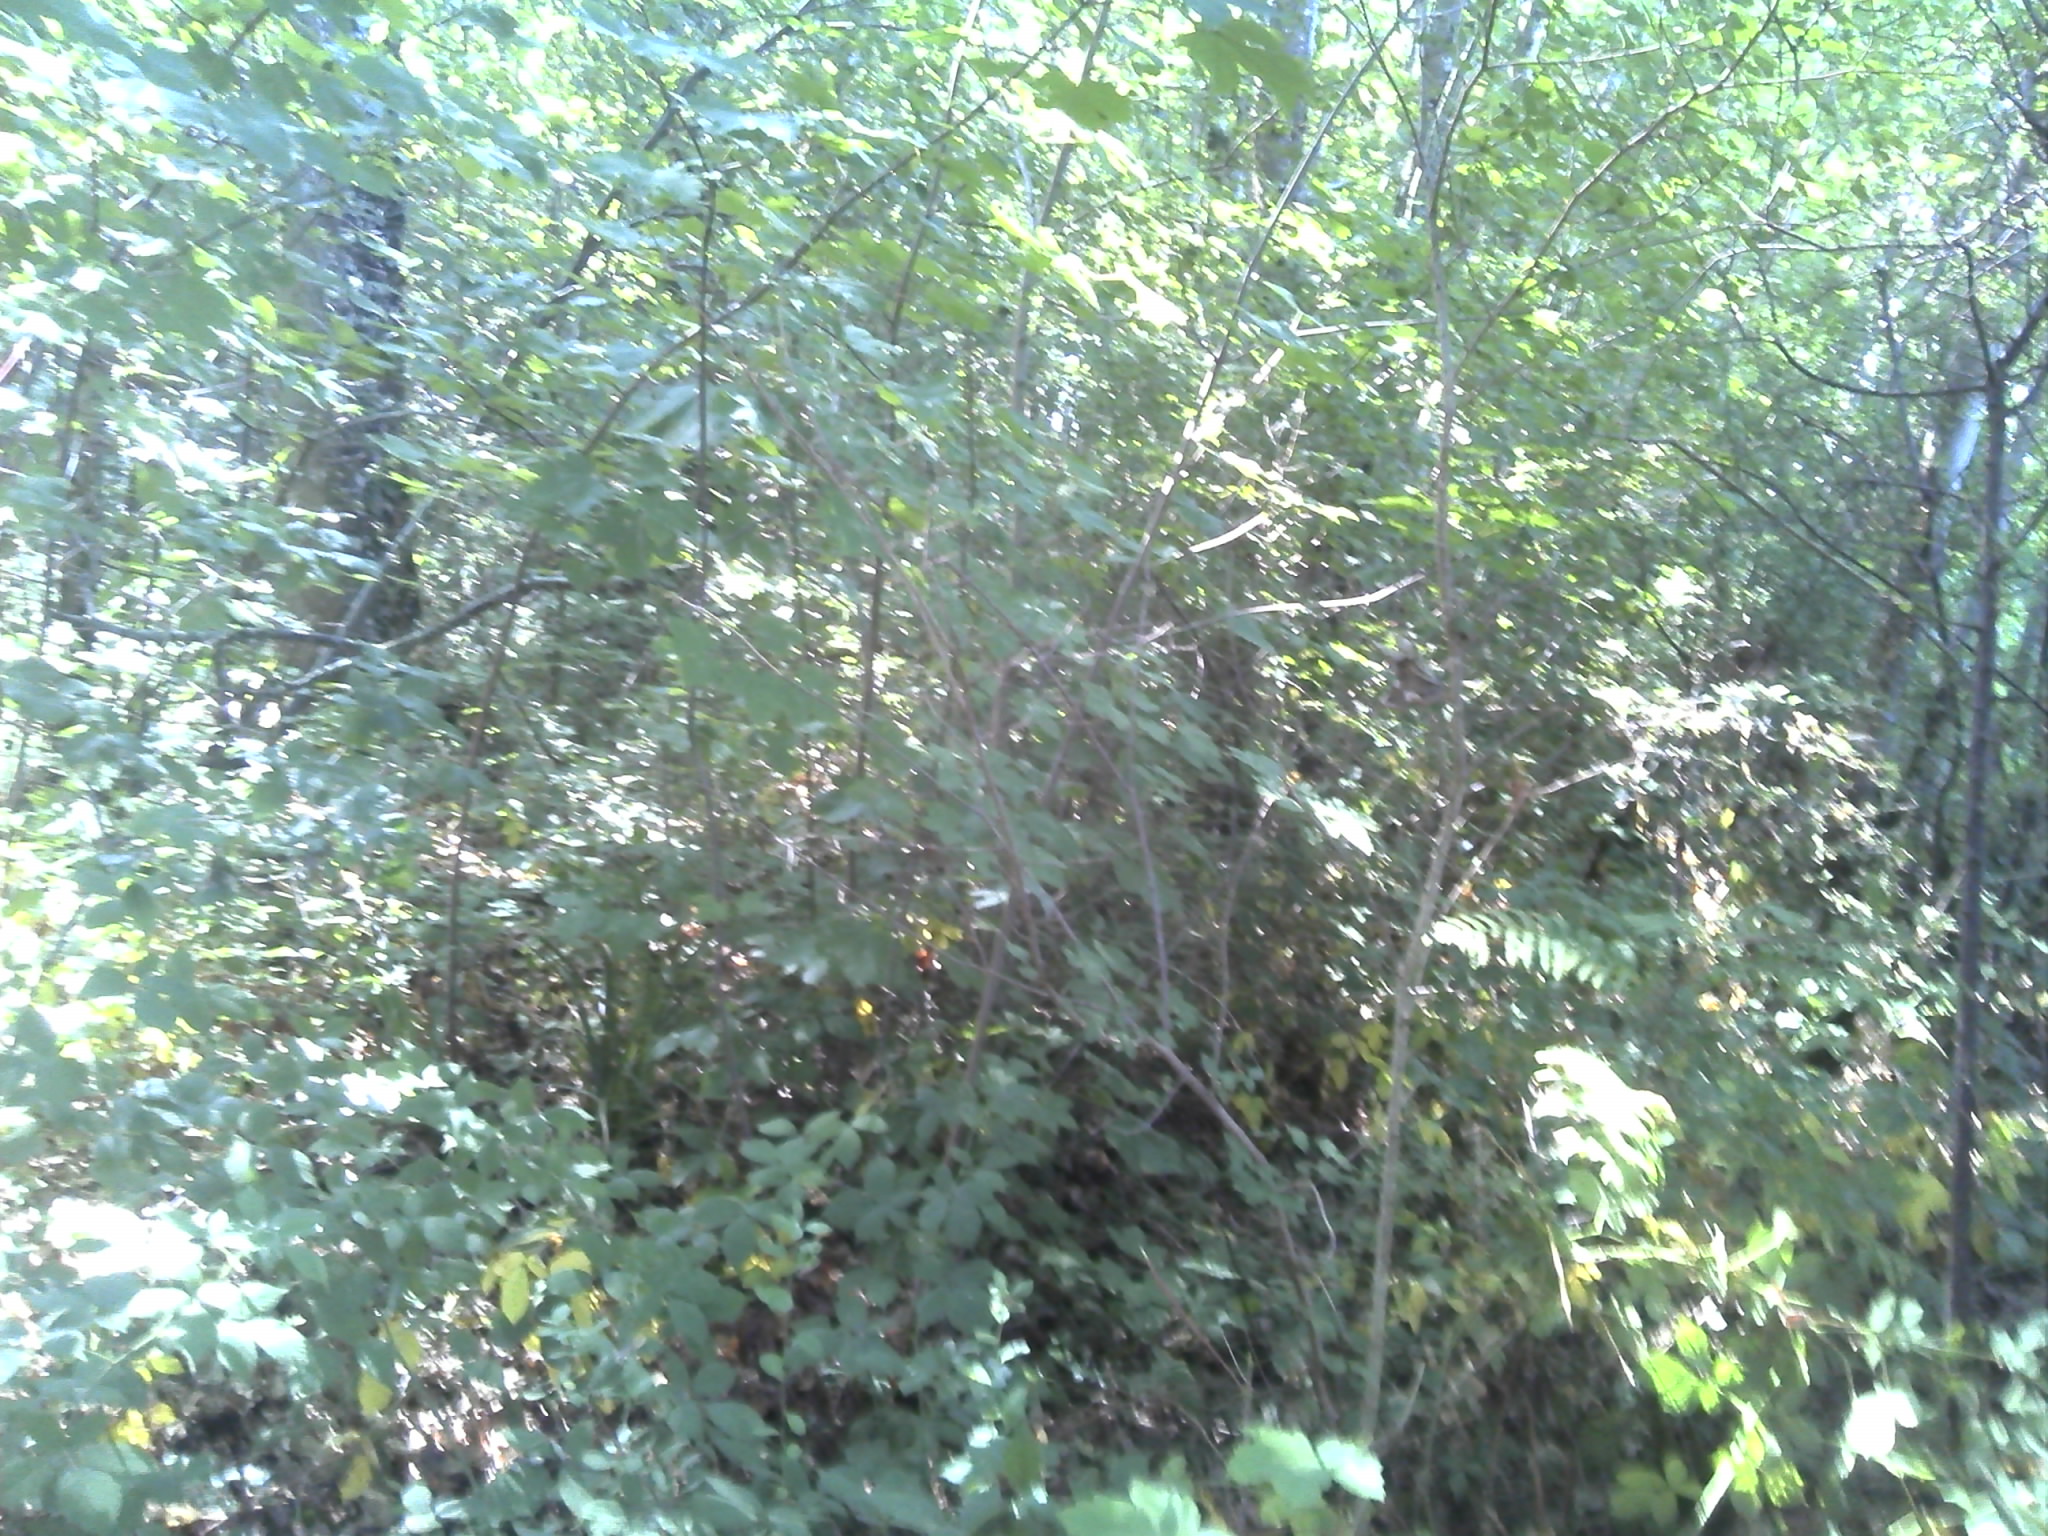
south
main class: Woodland
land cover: Broadleaved woodland
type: mesophytic deciduous forest
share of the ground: > 75 %
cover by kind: broadleaved forest trees 90 %, shrubs 5 %, herbaceous plants 5 %
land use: Forestry
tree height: > 5 m
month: July
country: FR
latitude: 47.0166
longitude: 1.6086
